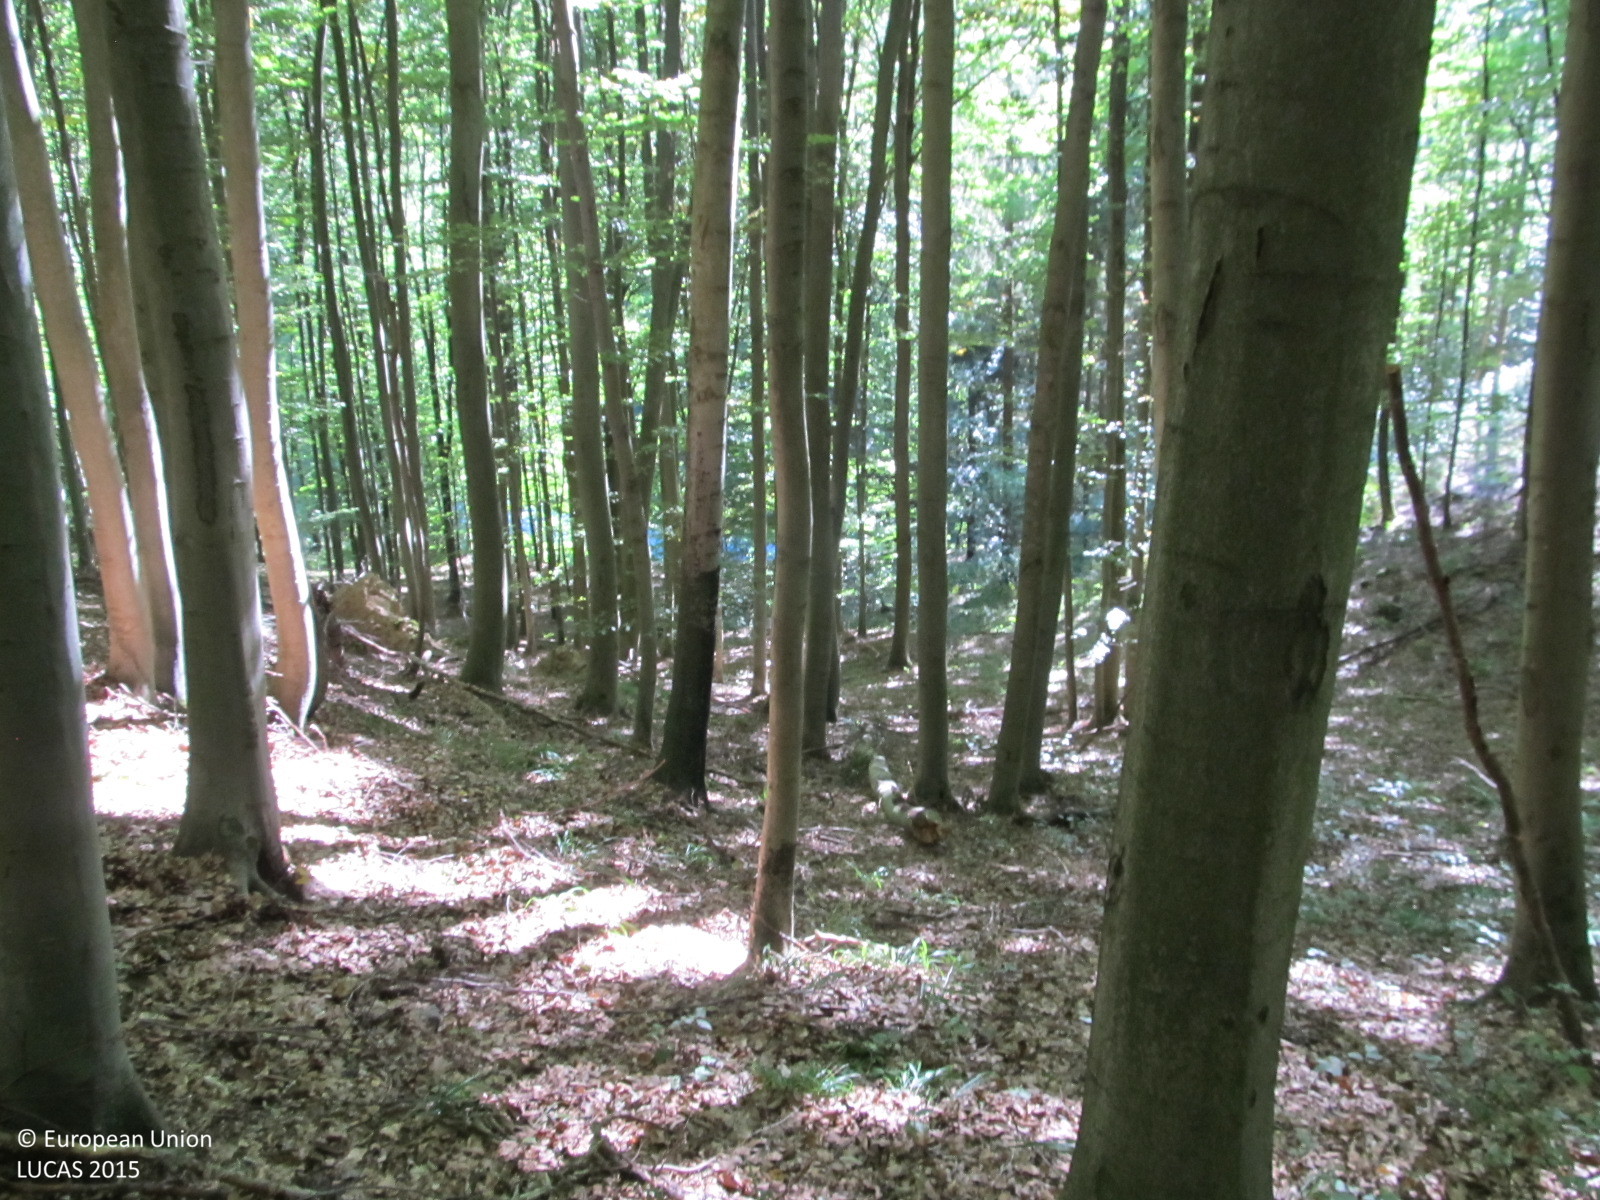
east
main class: Woodland
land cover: Broadleaved woodland
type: beech forest
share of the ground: > 75 %
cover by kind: broadleaved forest trees 85 %, unconsolidated bare surface 15 %
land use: Forestry
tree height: > 5 m
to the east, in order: Broadleaved woodland; Tracks; Spruce dominated mixed woodland; Grass margins; Paved roads, cycling and walking lanes; Grass margins; Broadleaved woodland; Rivers and streams; Other mixed woodland
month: September
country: AT
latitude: 48.5005
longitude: 15.5111
